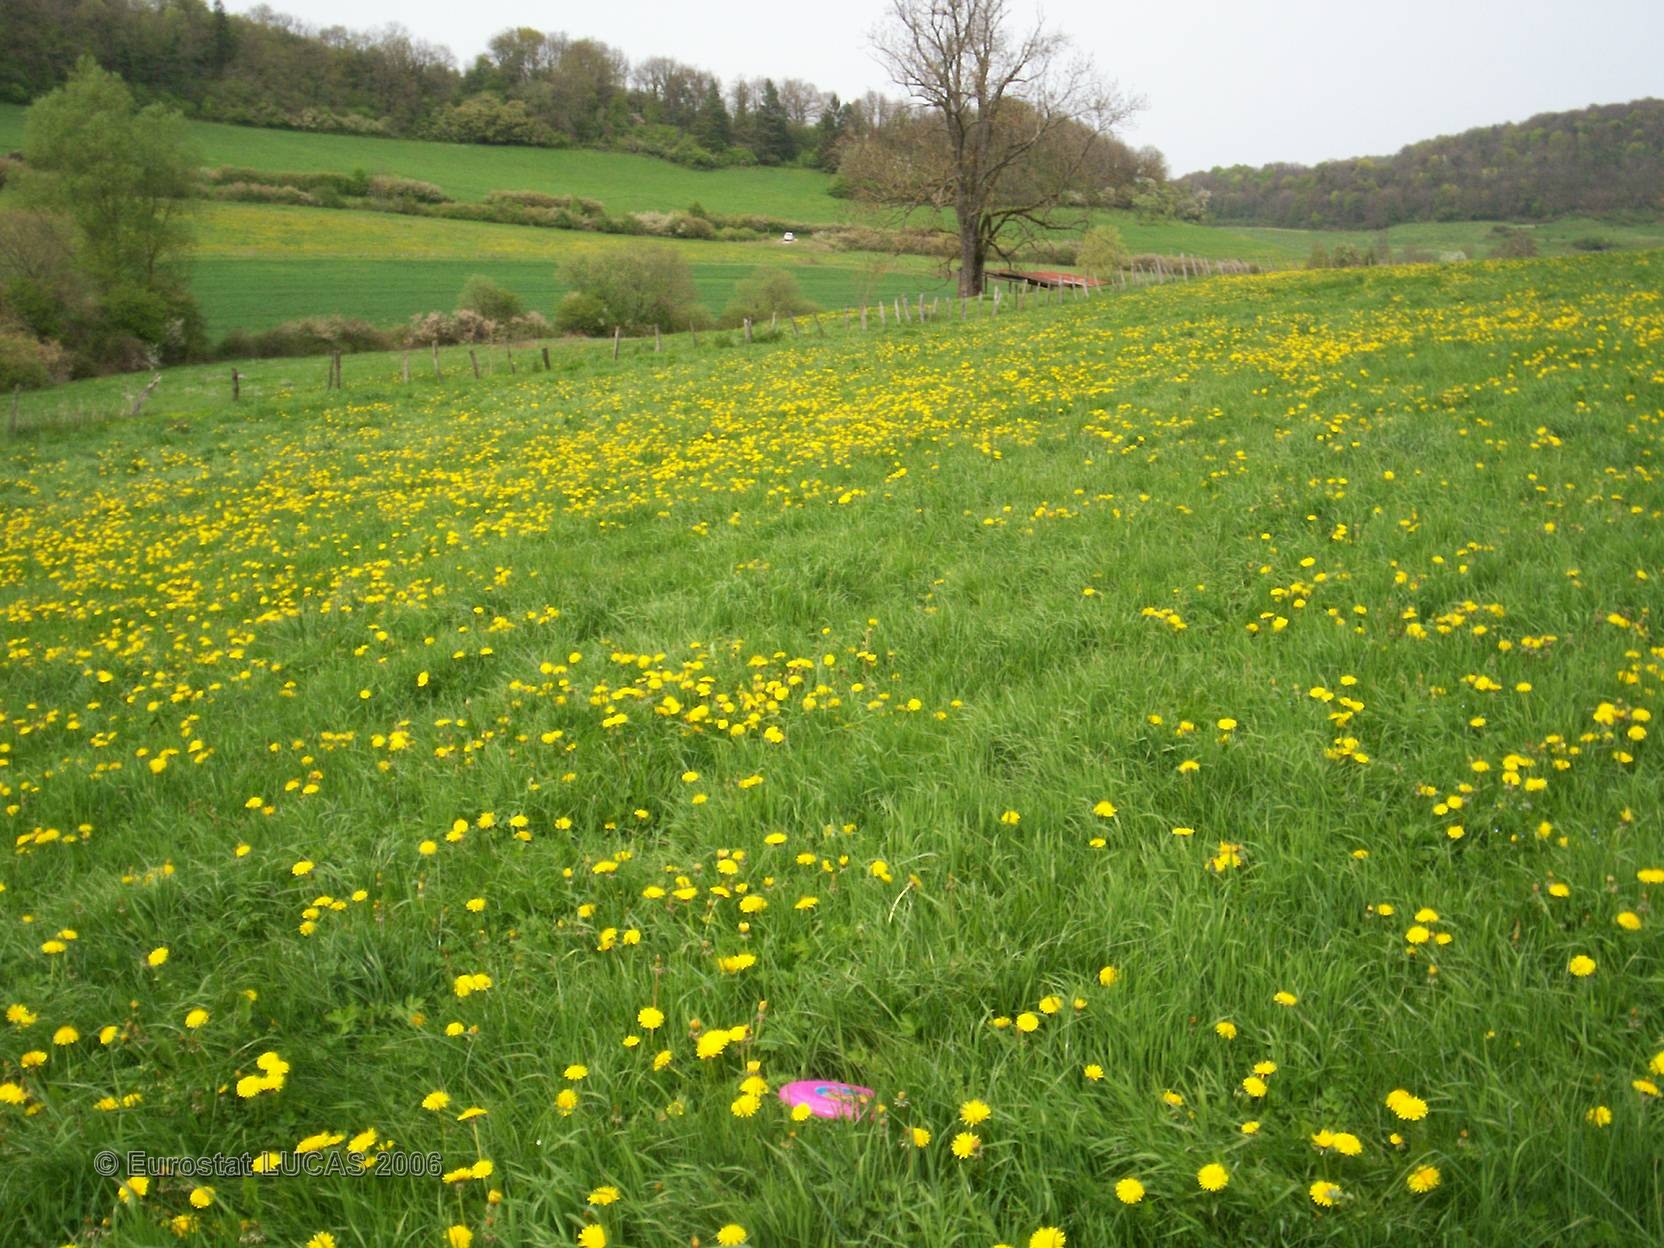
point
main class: Grassland
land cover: Grassland without tree/shrub cover
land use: Agriculture (excluding fallow land and kitchen gardens)
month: May
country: FR
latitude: 47.6946
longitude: 4.6025
